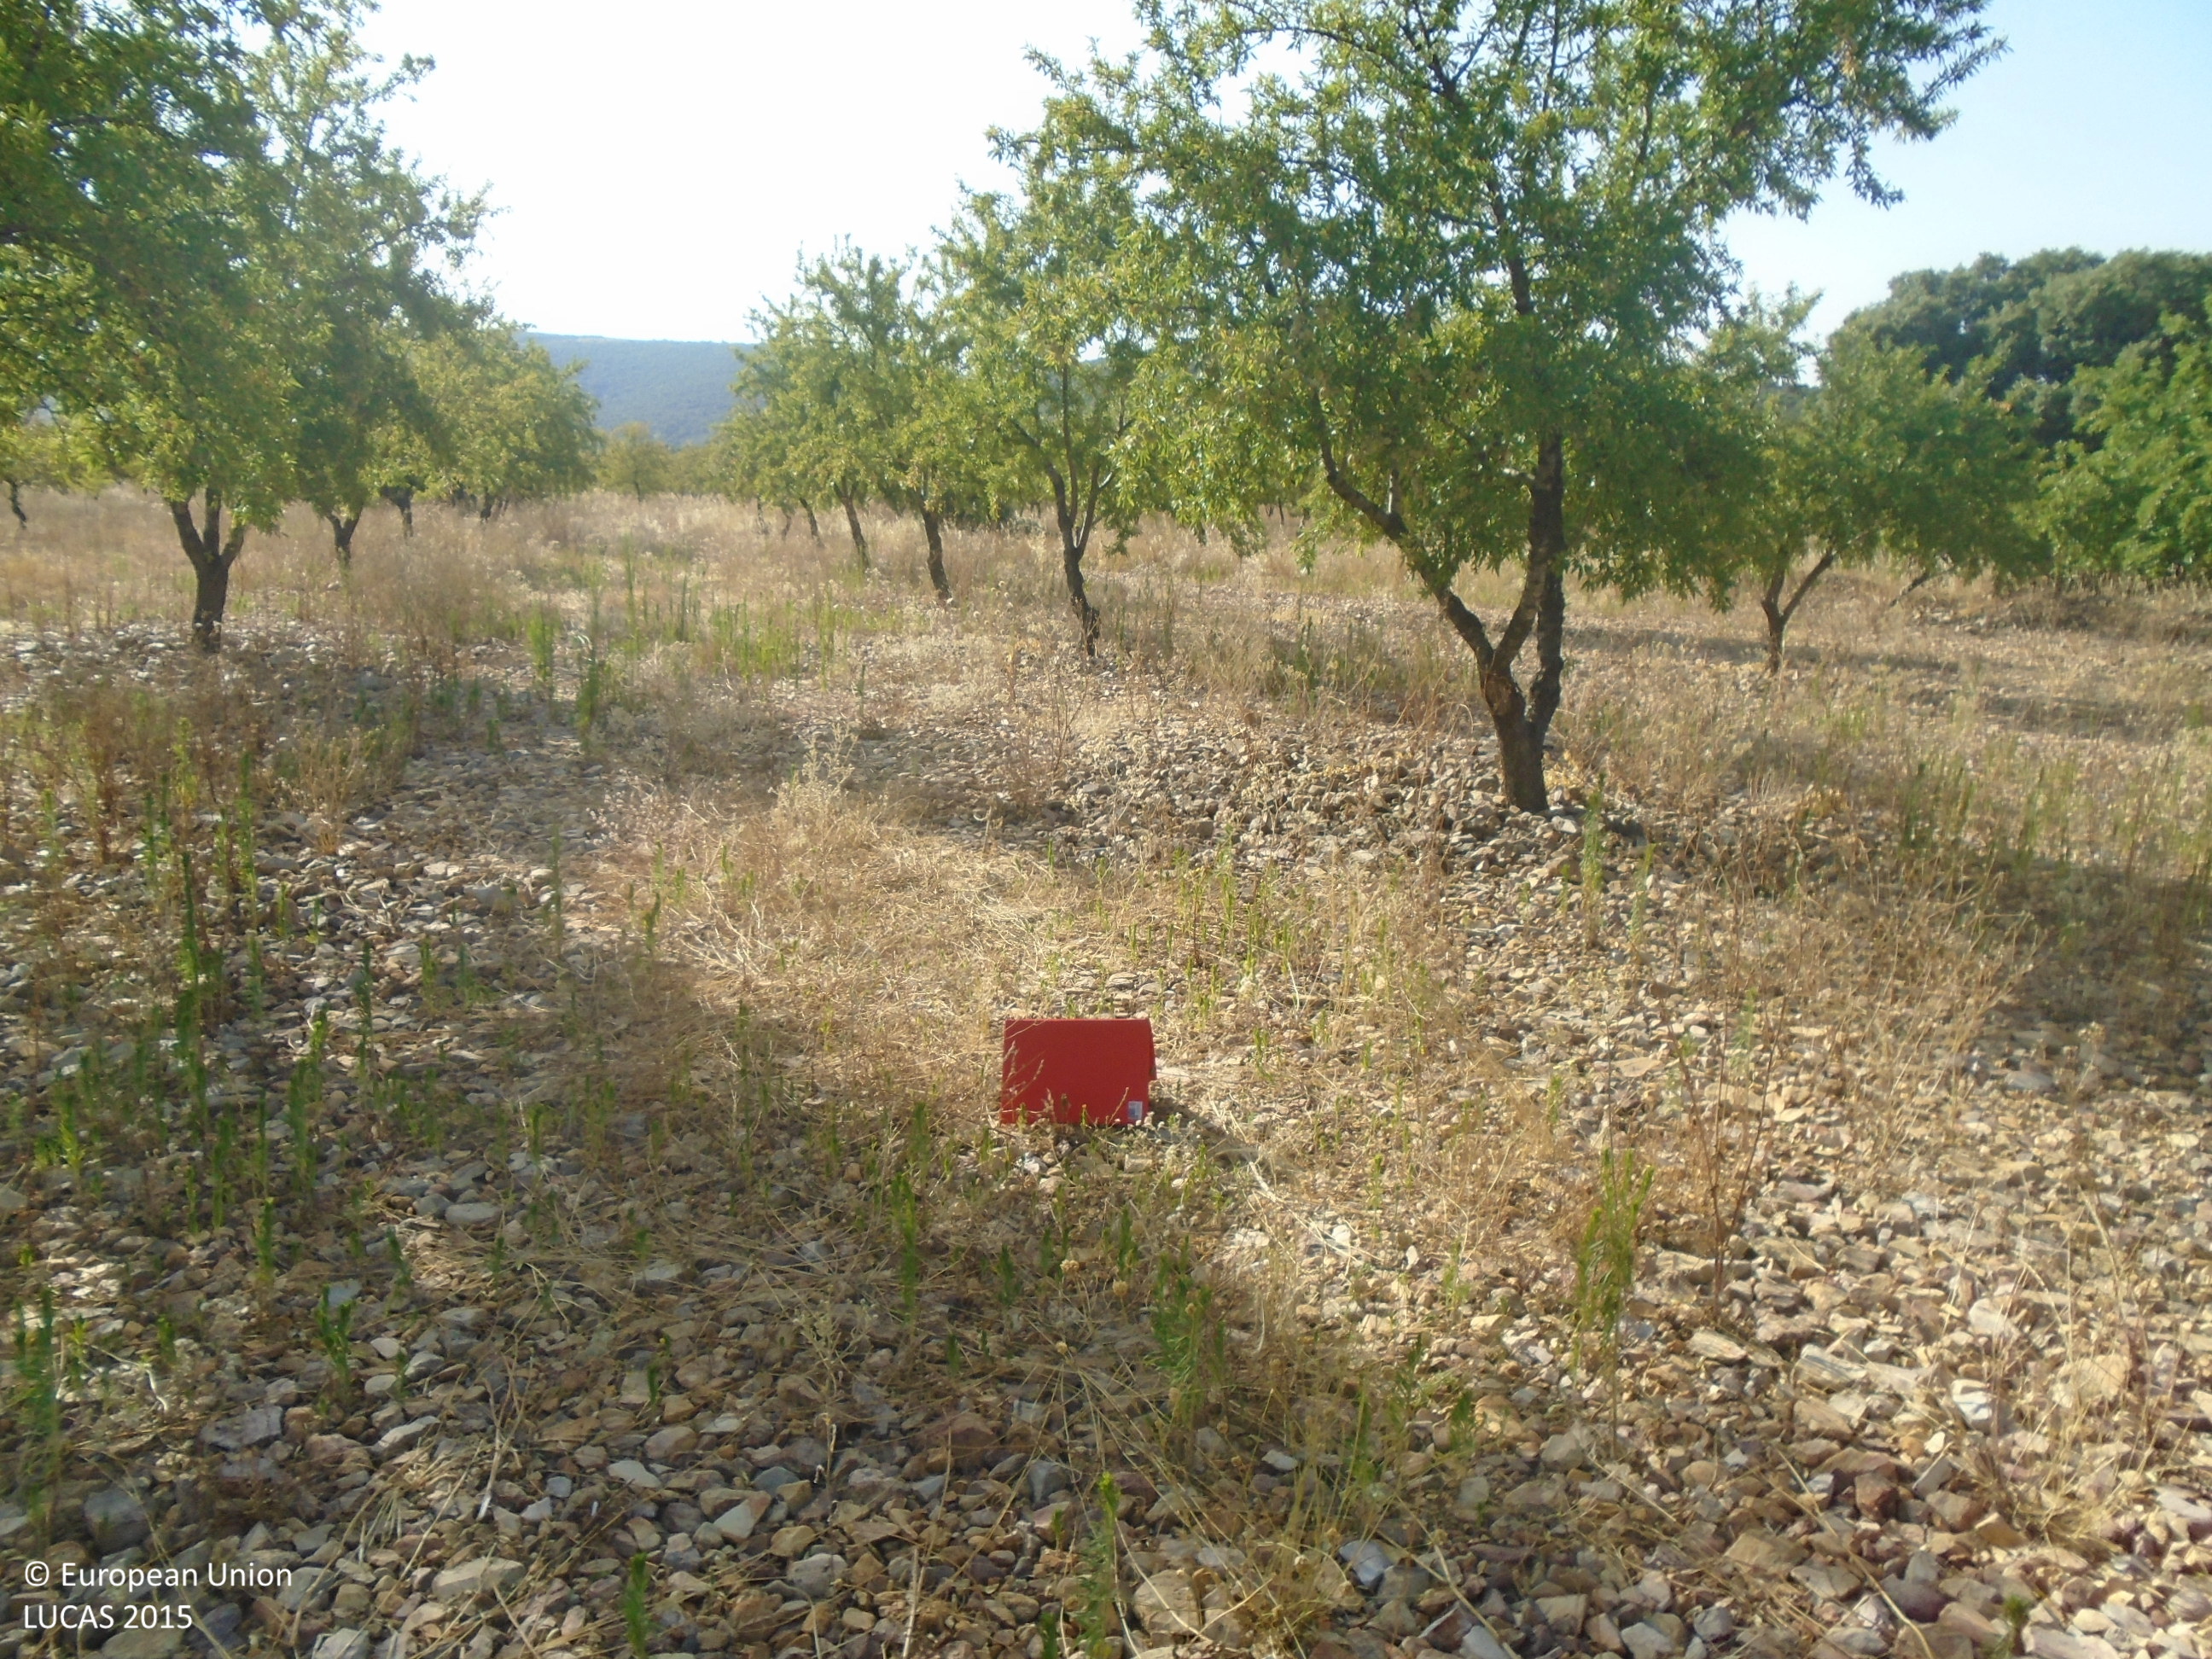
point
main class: Cropland
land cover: Nuts trees
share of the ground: 10 - 25 %
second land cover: Spontaneously vegetated surfaces
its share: > 75 %
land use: Agriculture (excluding fallow land and kitchen gardens)
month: July
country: ES
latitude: 39.2428
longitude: -4.1040
